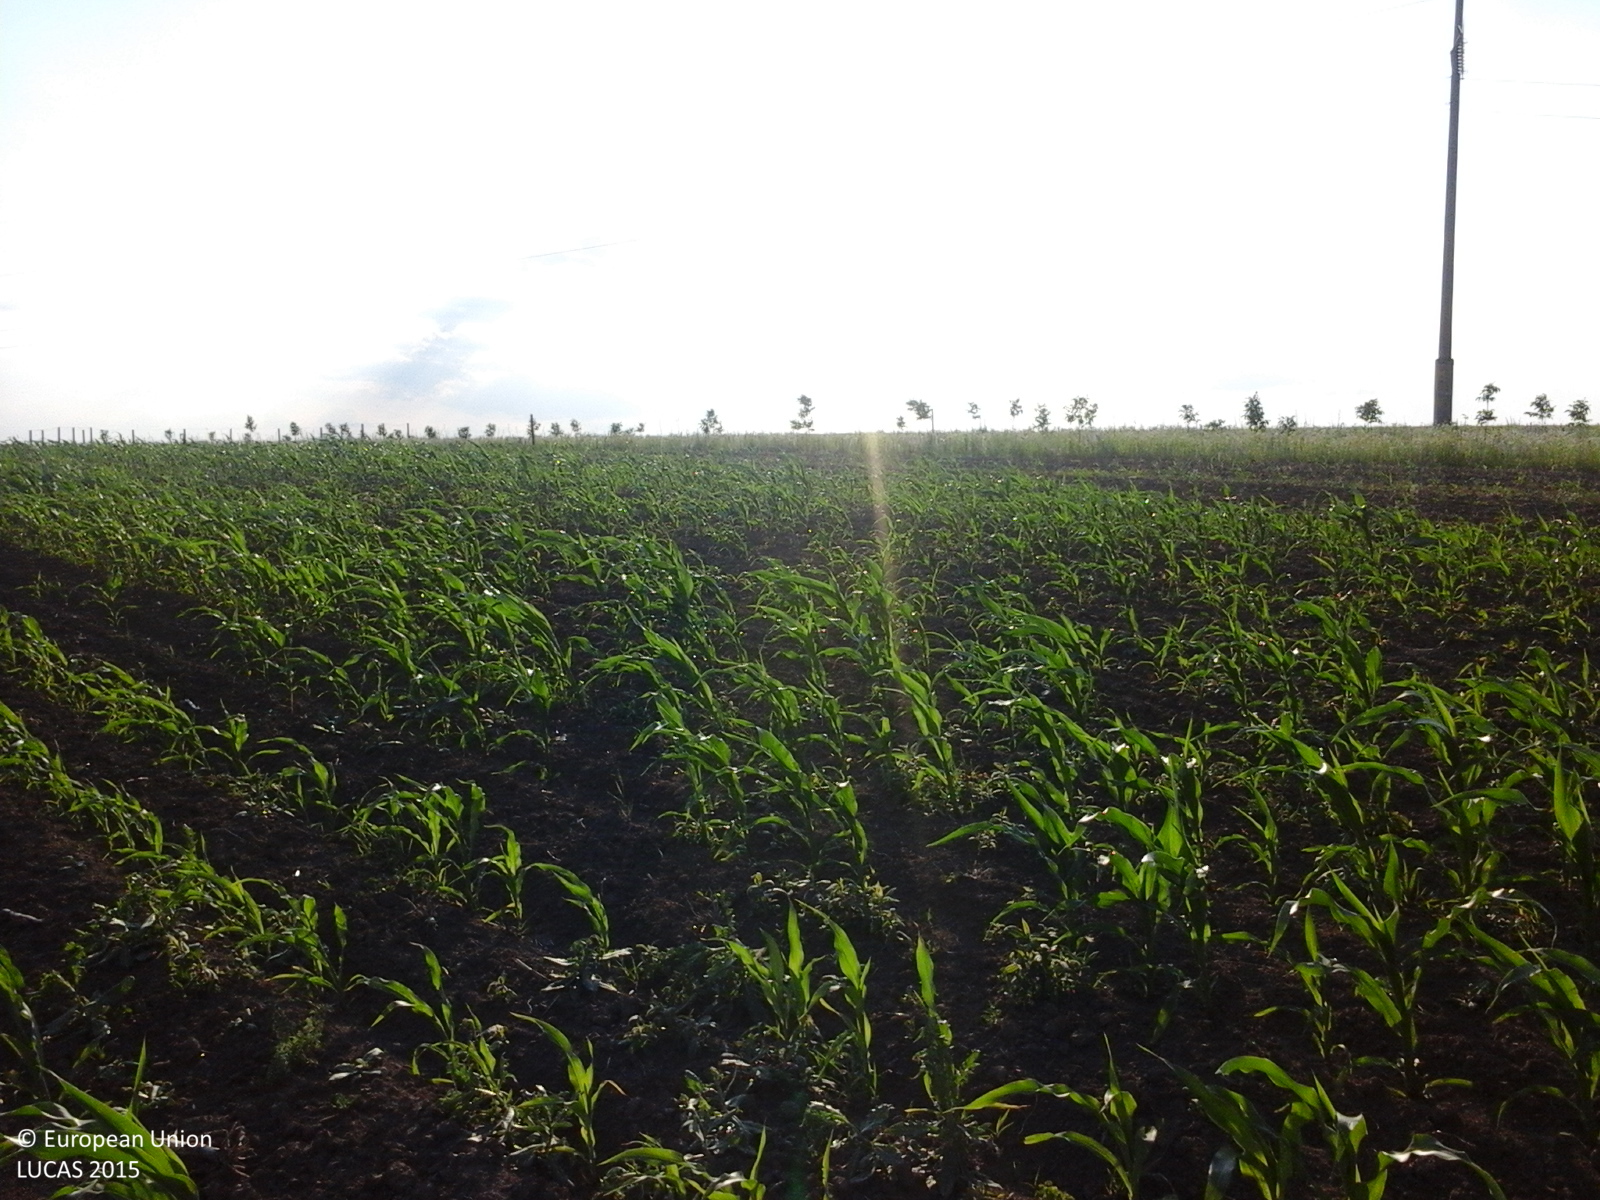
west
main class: Cropland
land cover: Maize
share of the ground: 25 - 50 %
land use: Agriculture (excluding fallow land and kitchen gardens)
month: June
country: RO
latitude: 47.7080
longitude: 26.4692
